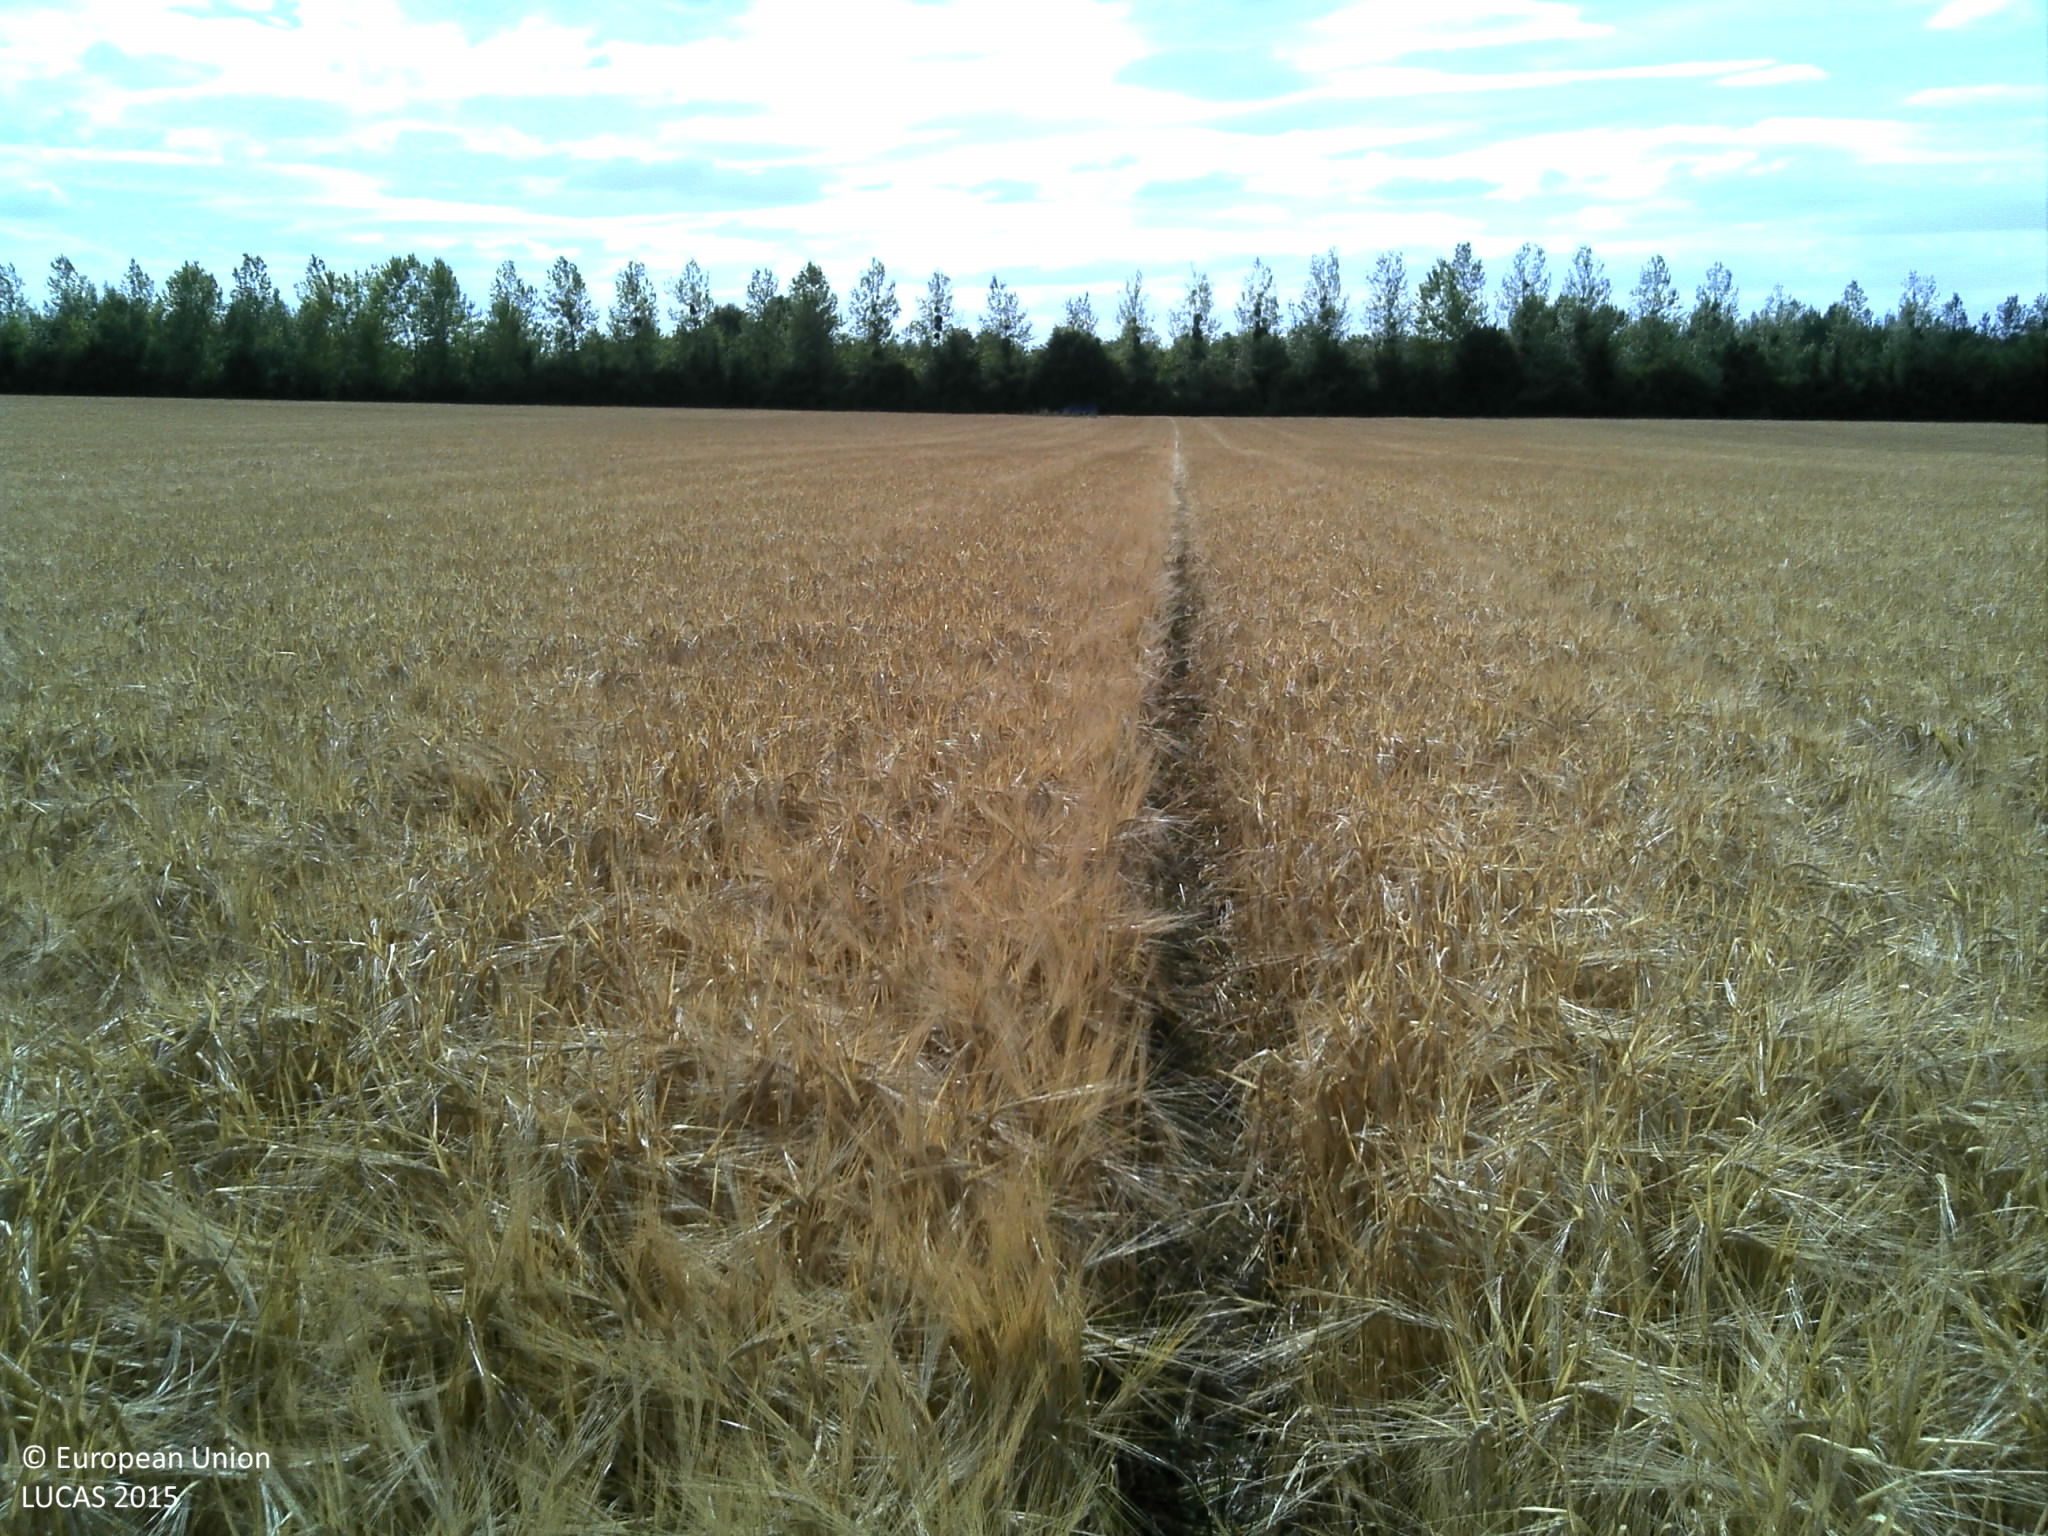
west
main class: Cropland
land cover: Barley
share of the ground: > 75 %
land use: Agriculture (excluding fallow land and kitchen gardens)
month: July
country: FR
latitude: 48.6148
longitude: 4.6123
